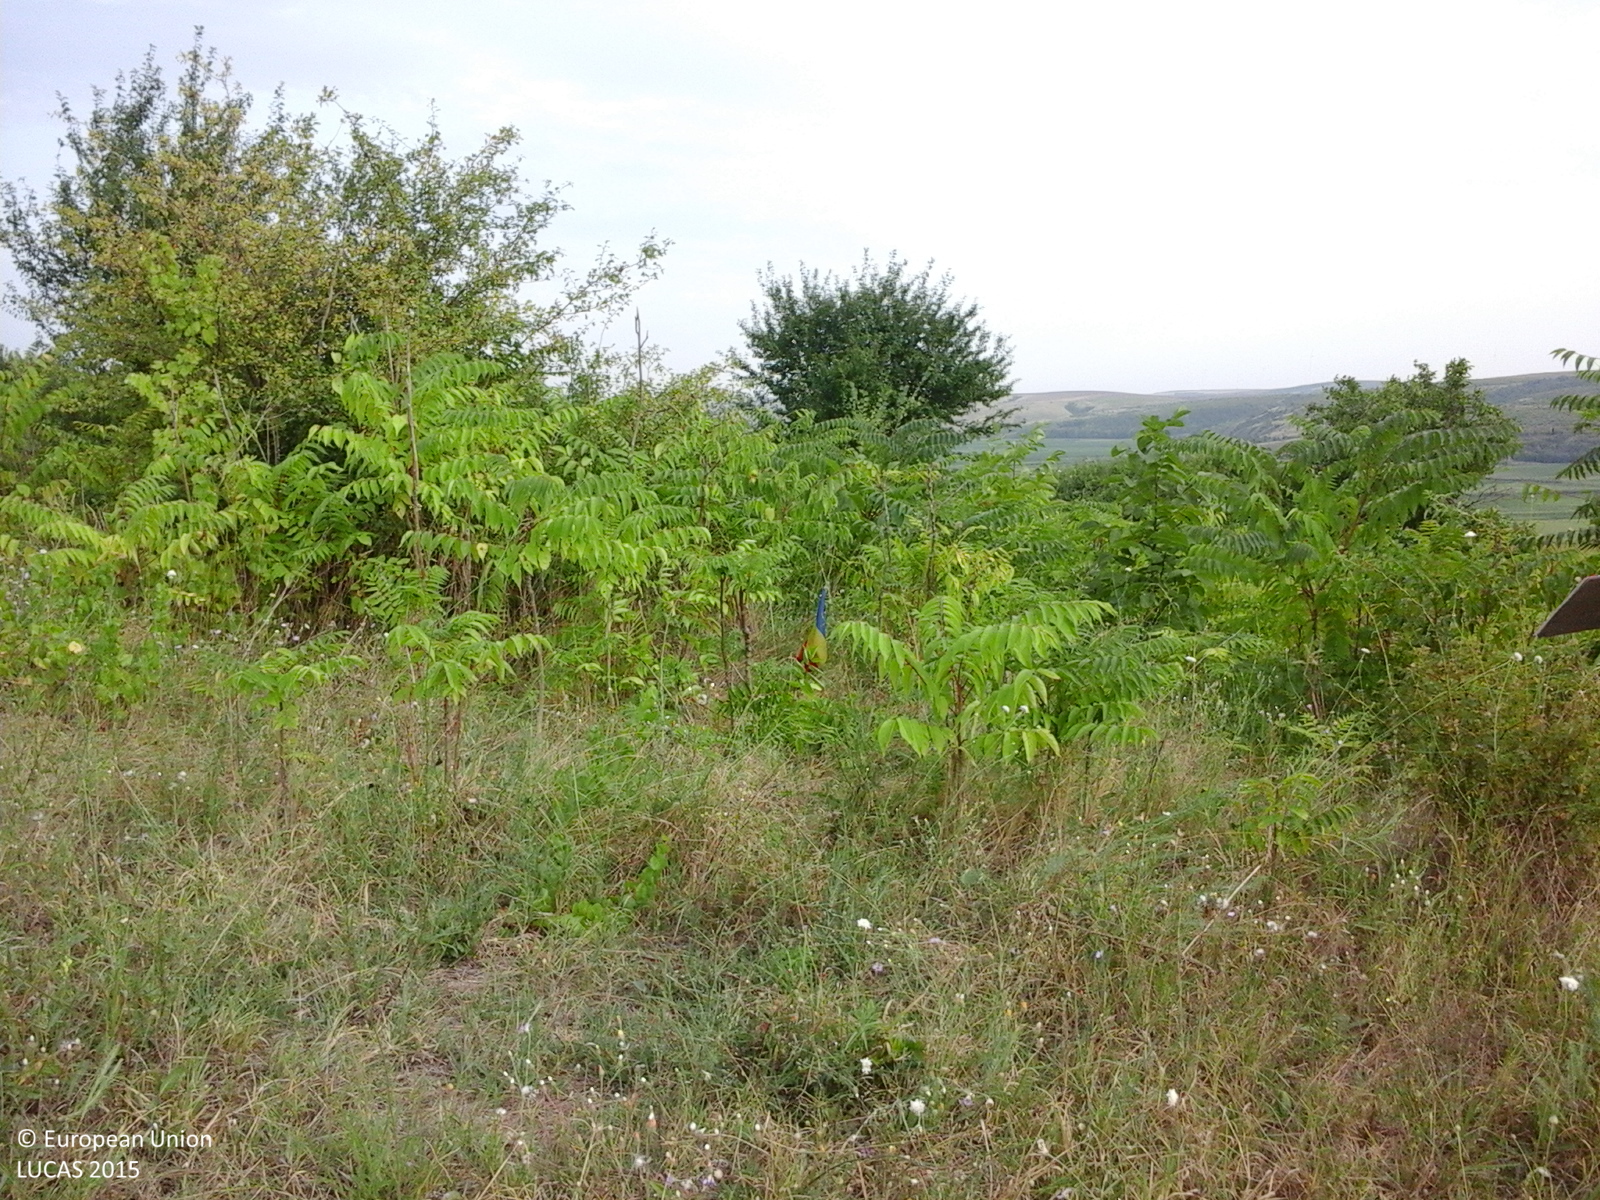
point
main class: Shrubland
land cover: Shrubland with sparse tree cover
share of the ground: > 75 %
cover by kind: shrubs 85 %, herbaceous plants 10 %, broadleaved forest trees 5 %
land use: Semi-natural and natural areas not in use
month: August
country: RO
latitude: 44.2715
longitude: 28.0081
